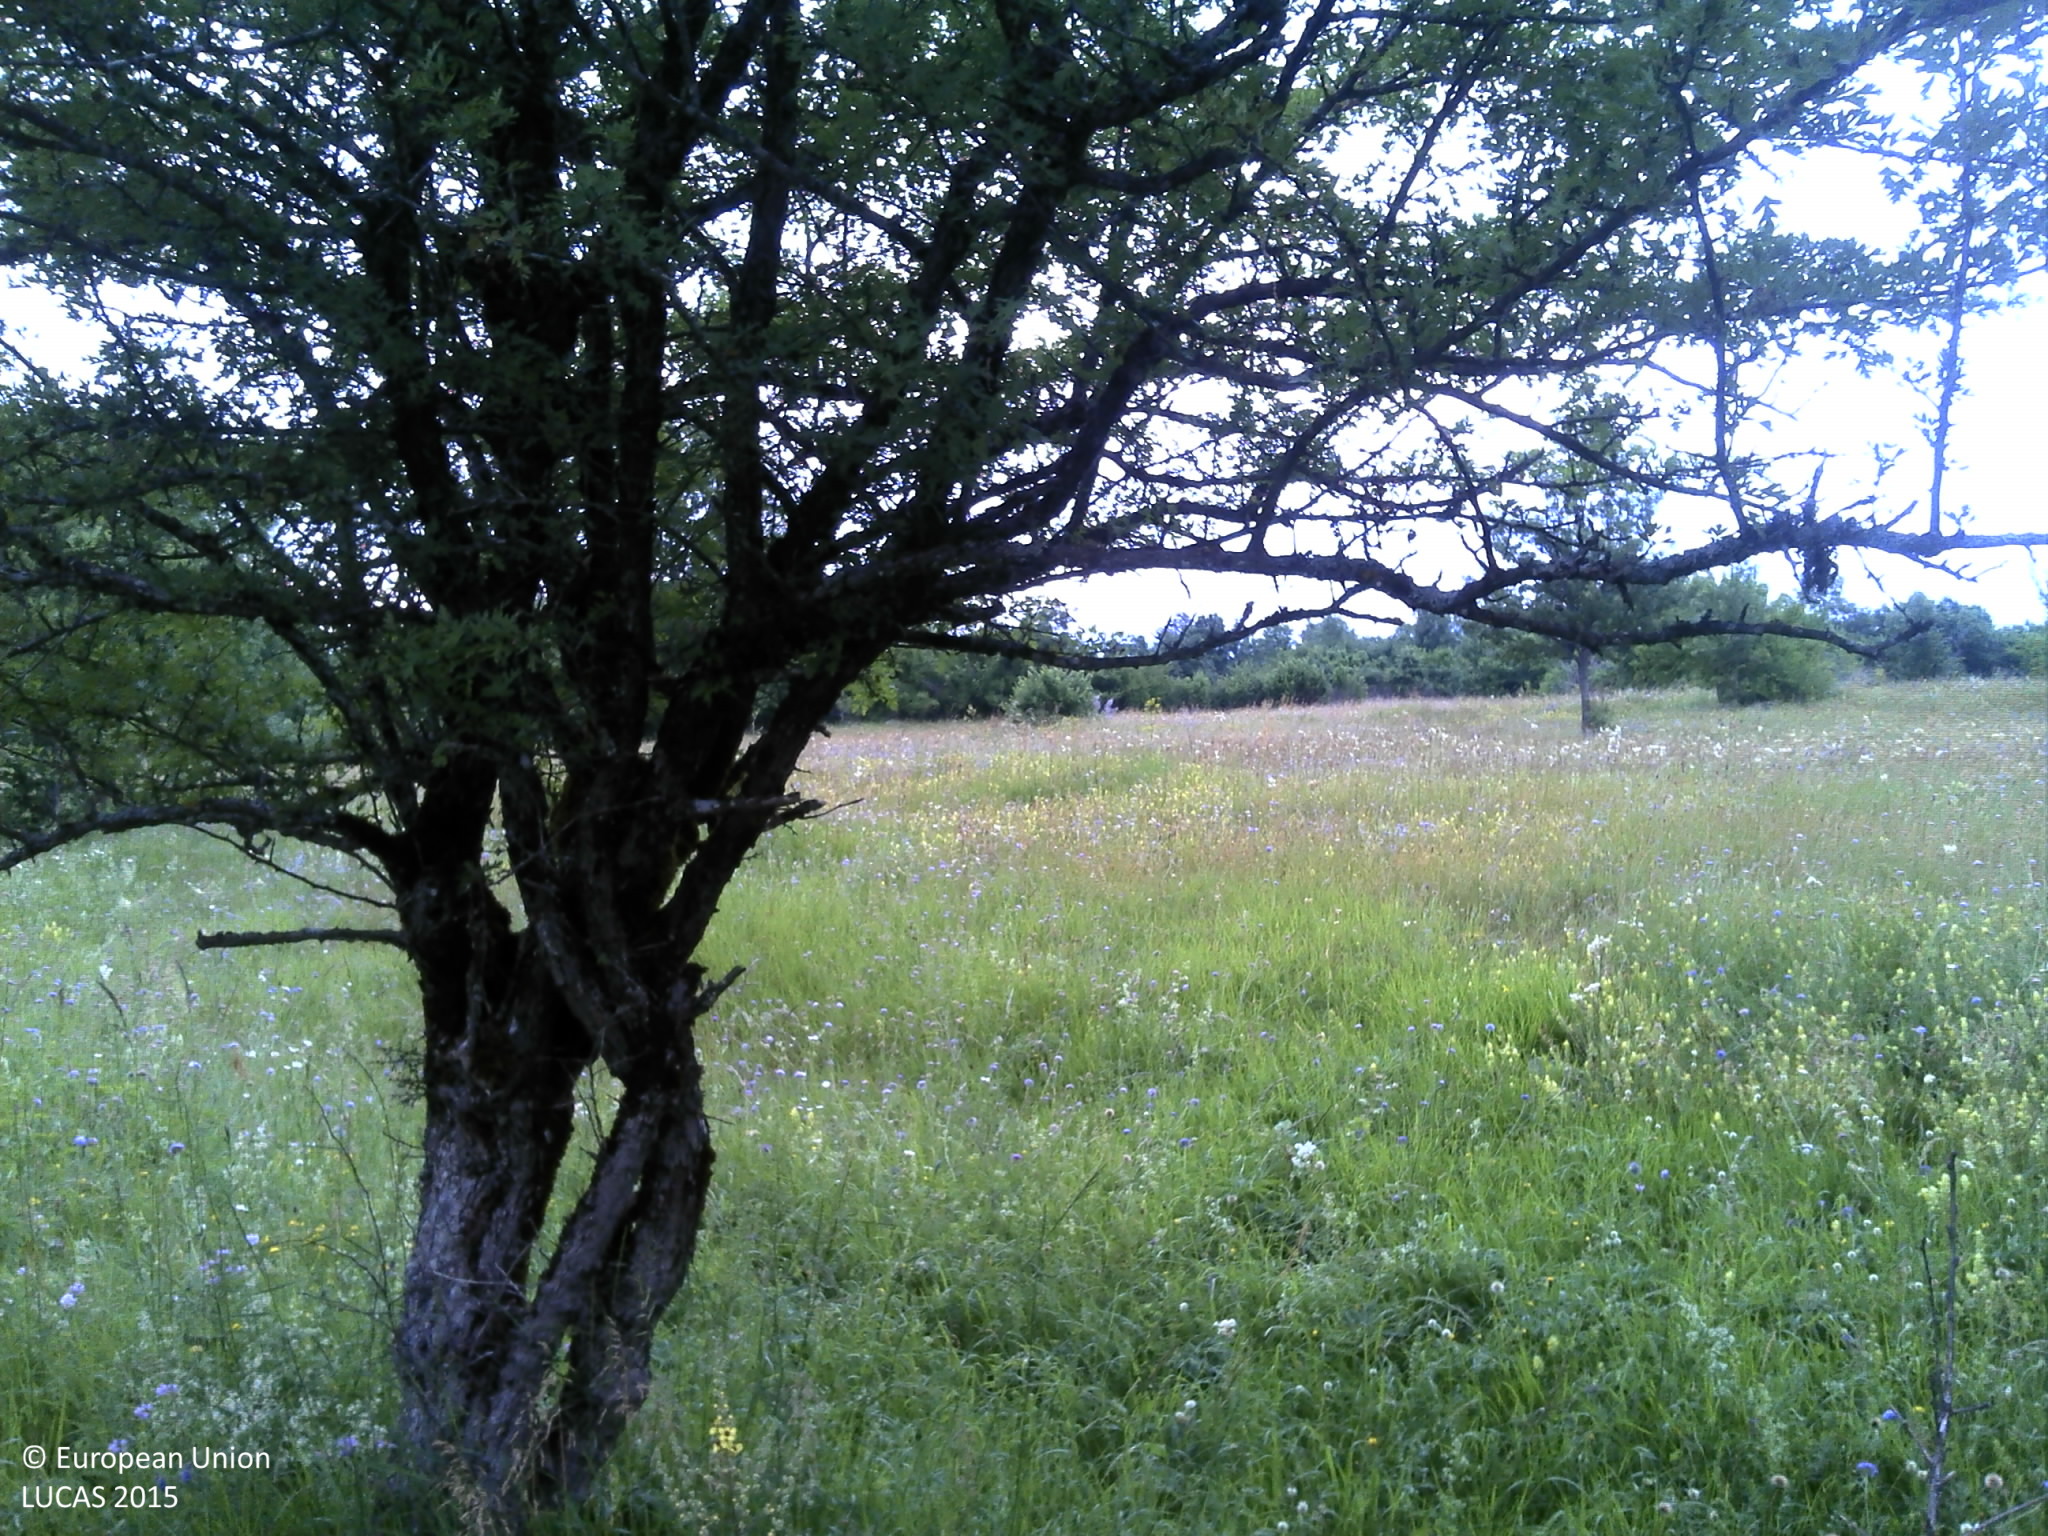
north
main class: Woodland
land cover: Broadleaved woodland
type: beech forest
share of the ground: > 75 %
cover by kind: broadleaved forest trees 90 %, herbaceous plants 10 %
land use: Semi-natural and natural areas not in use
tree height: > 5 m
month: June
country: HR
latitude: 44.3758
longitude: 15.6784
